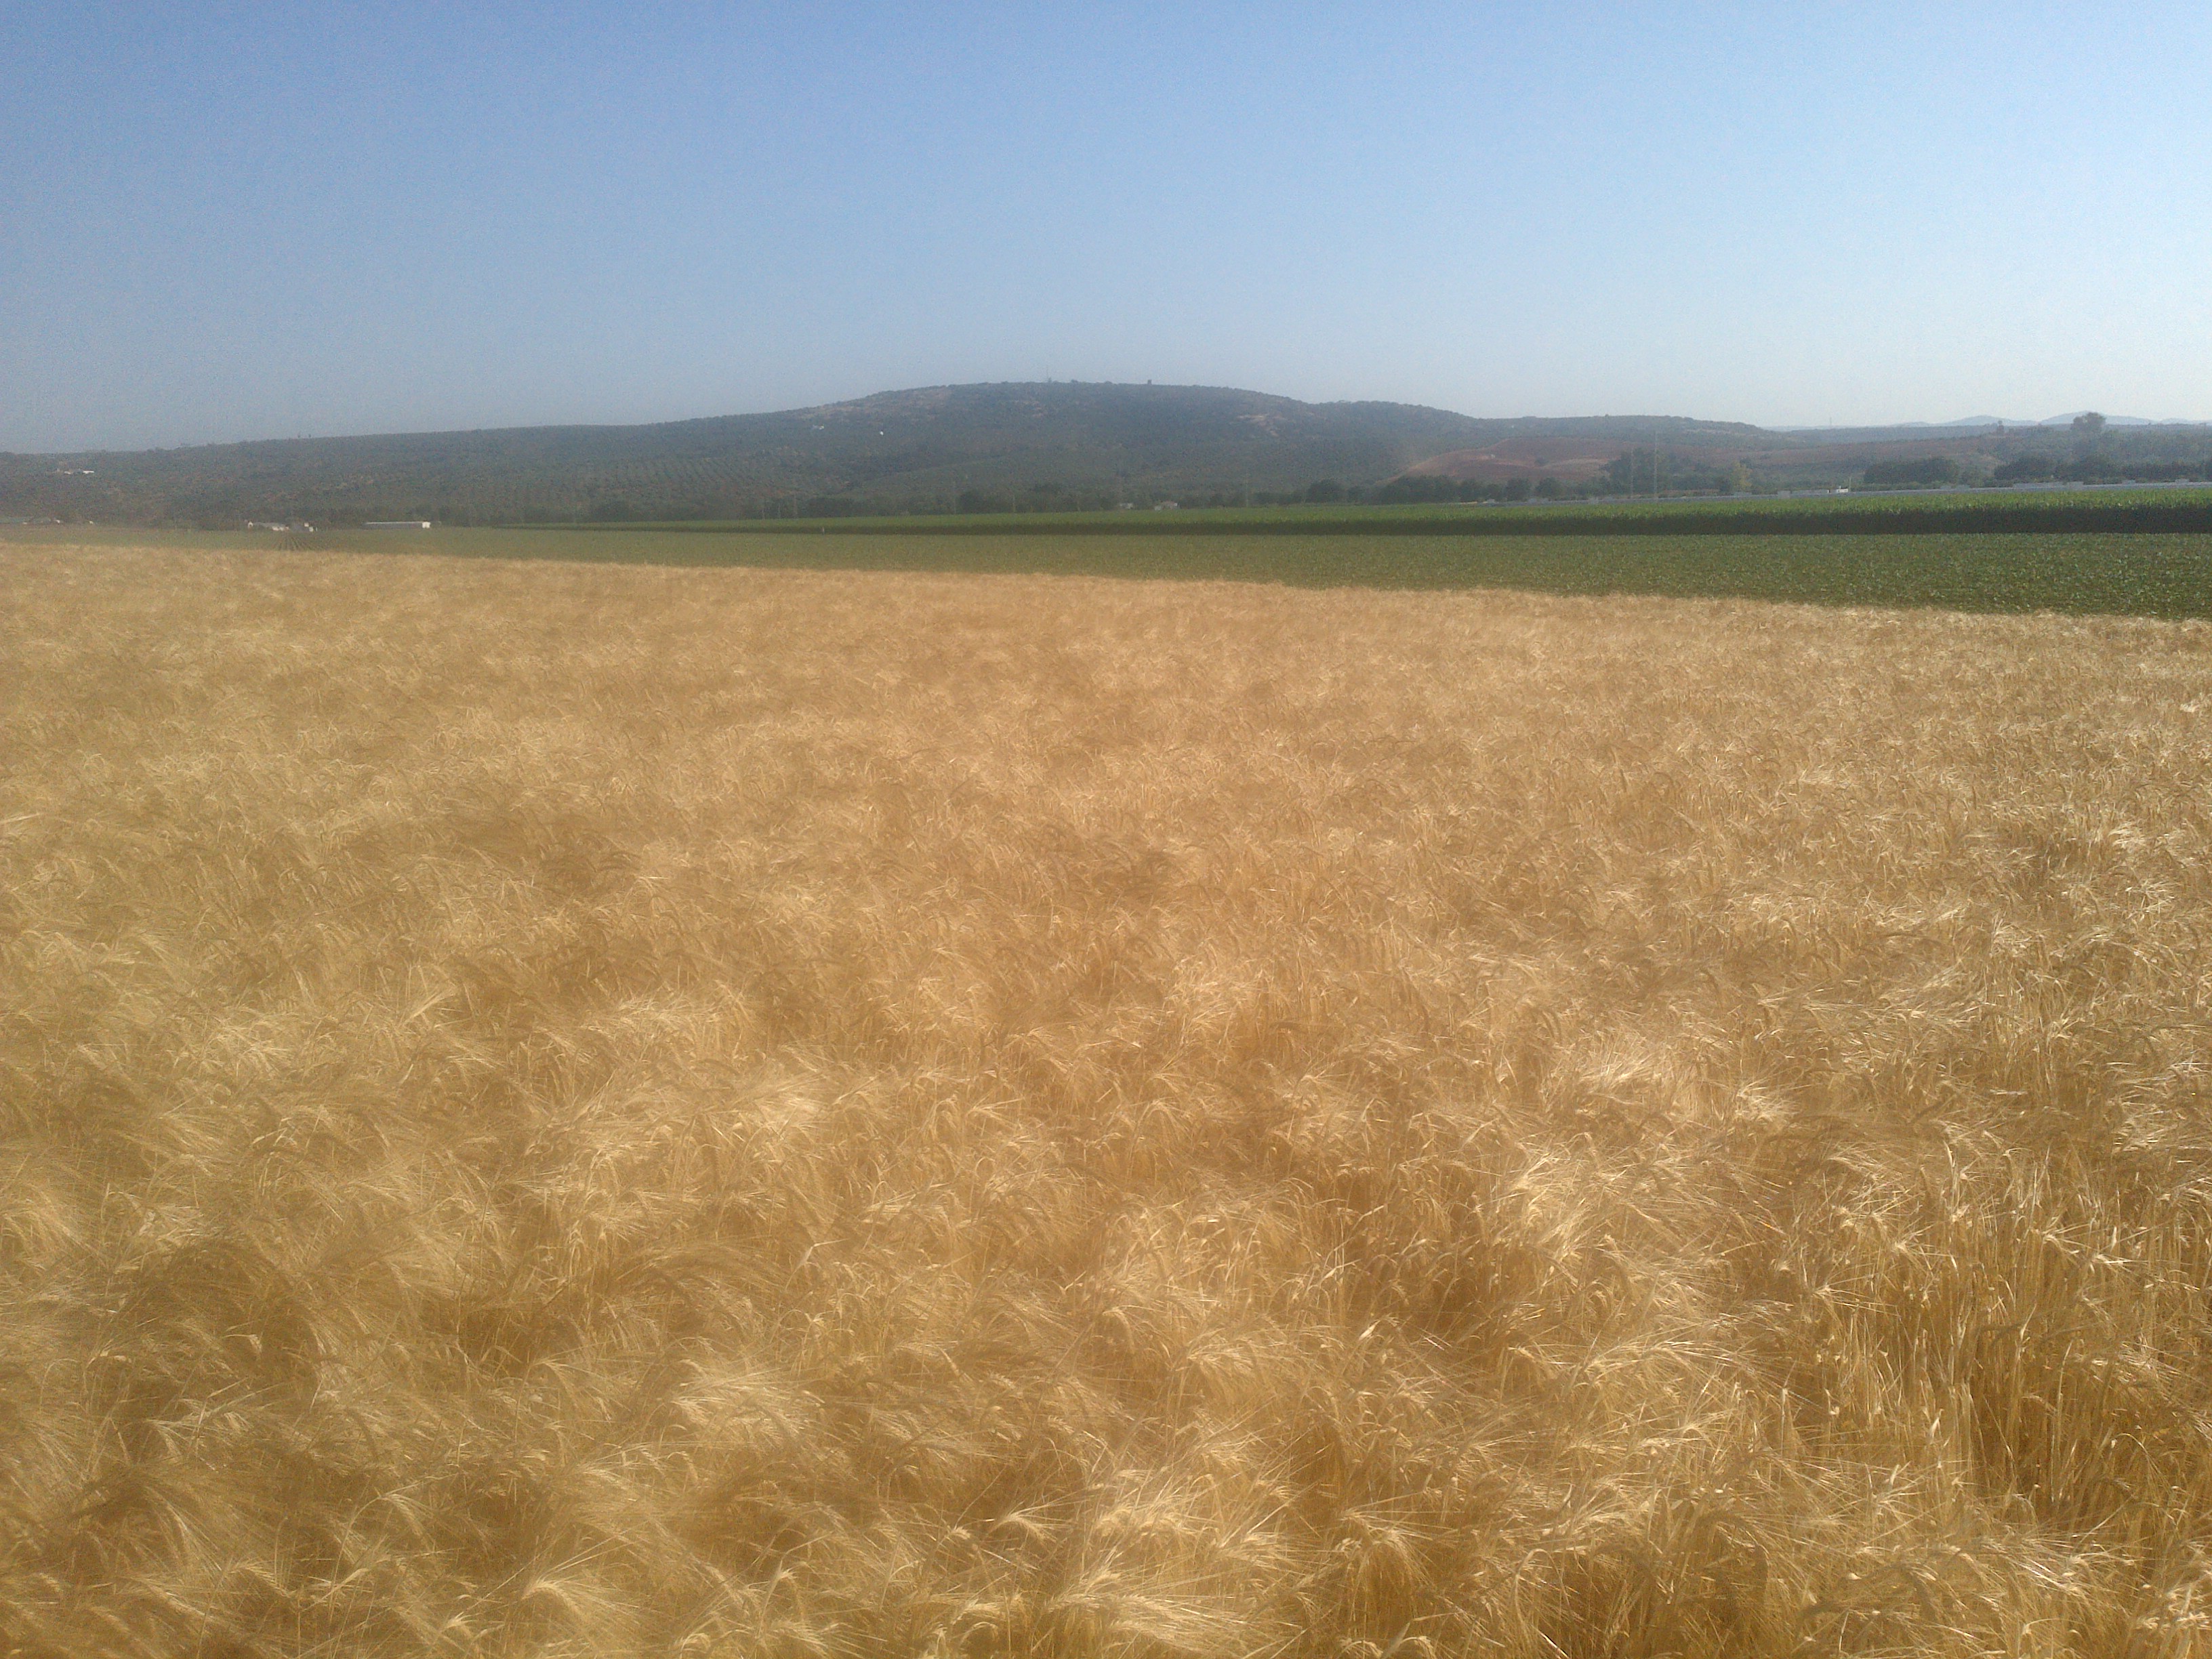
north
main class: Cropland
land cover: Barley
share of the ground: > 75 %
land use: Agriculture (excluding fallow land and kitchen gardens)
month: June
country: ES
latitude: 37.9985
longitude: -4.3248
